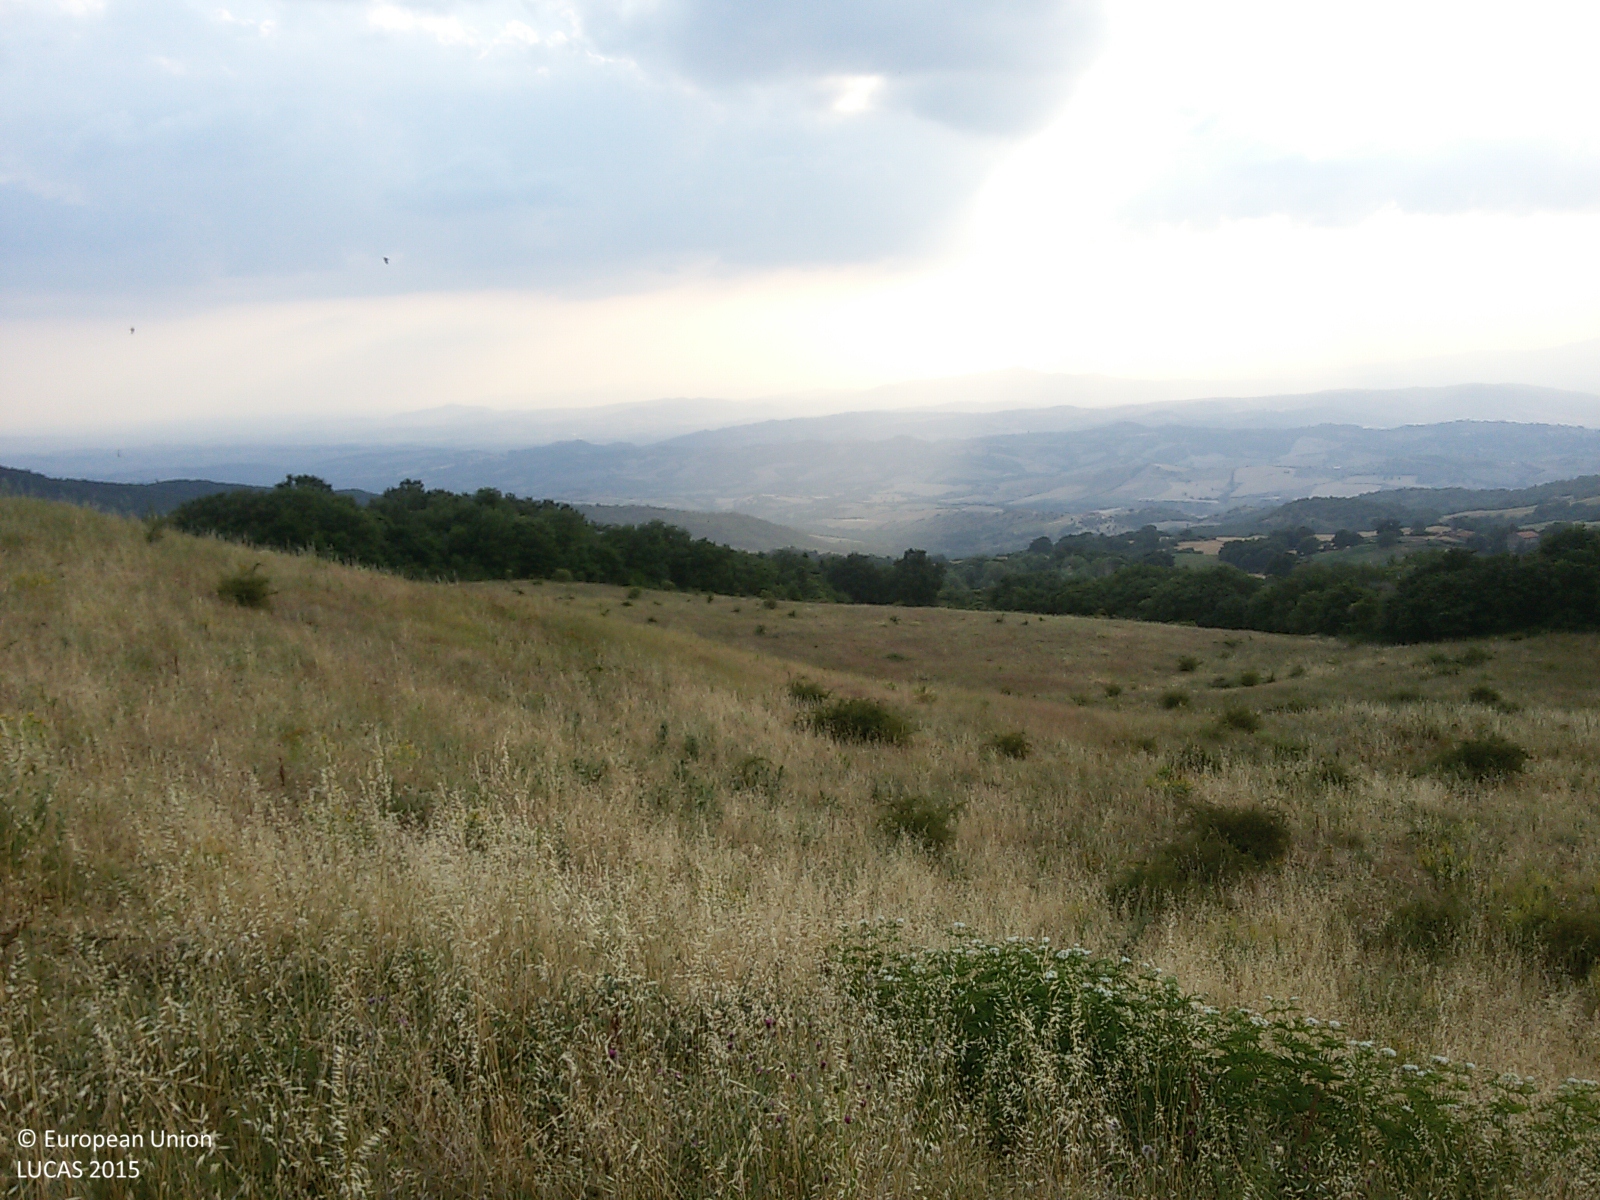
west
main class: Cropland
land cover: Temporary grasslands
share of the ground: > 75 %
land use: Agriculture (excluding fallow land and kitchen gardens)
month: July
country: IT
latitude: 42.8604
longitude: 11.4518
